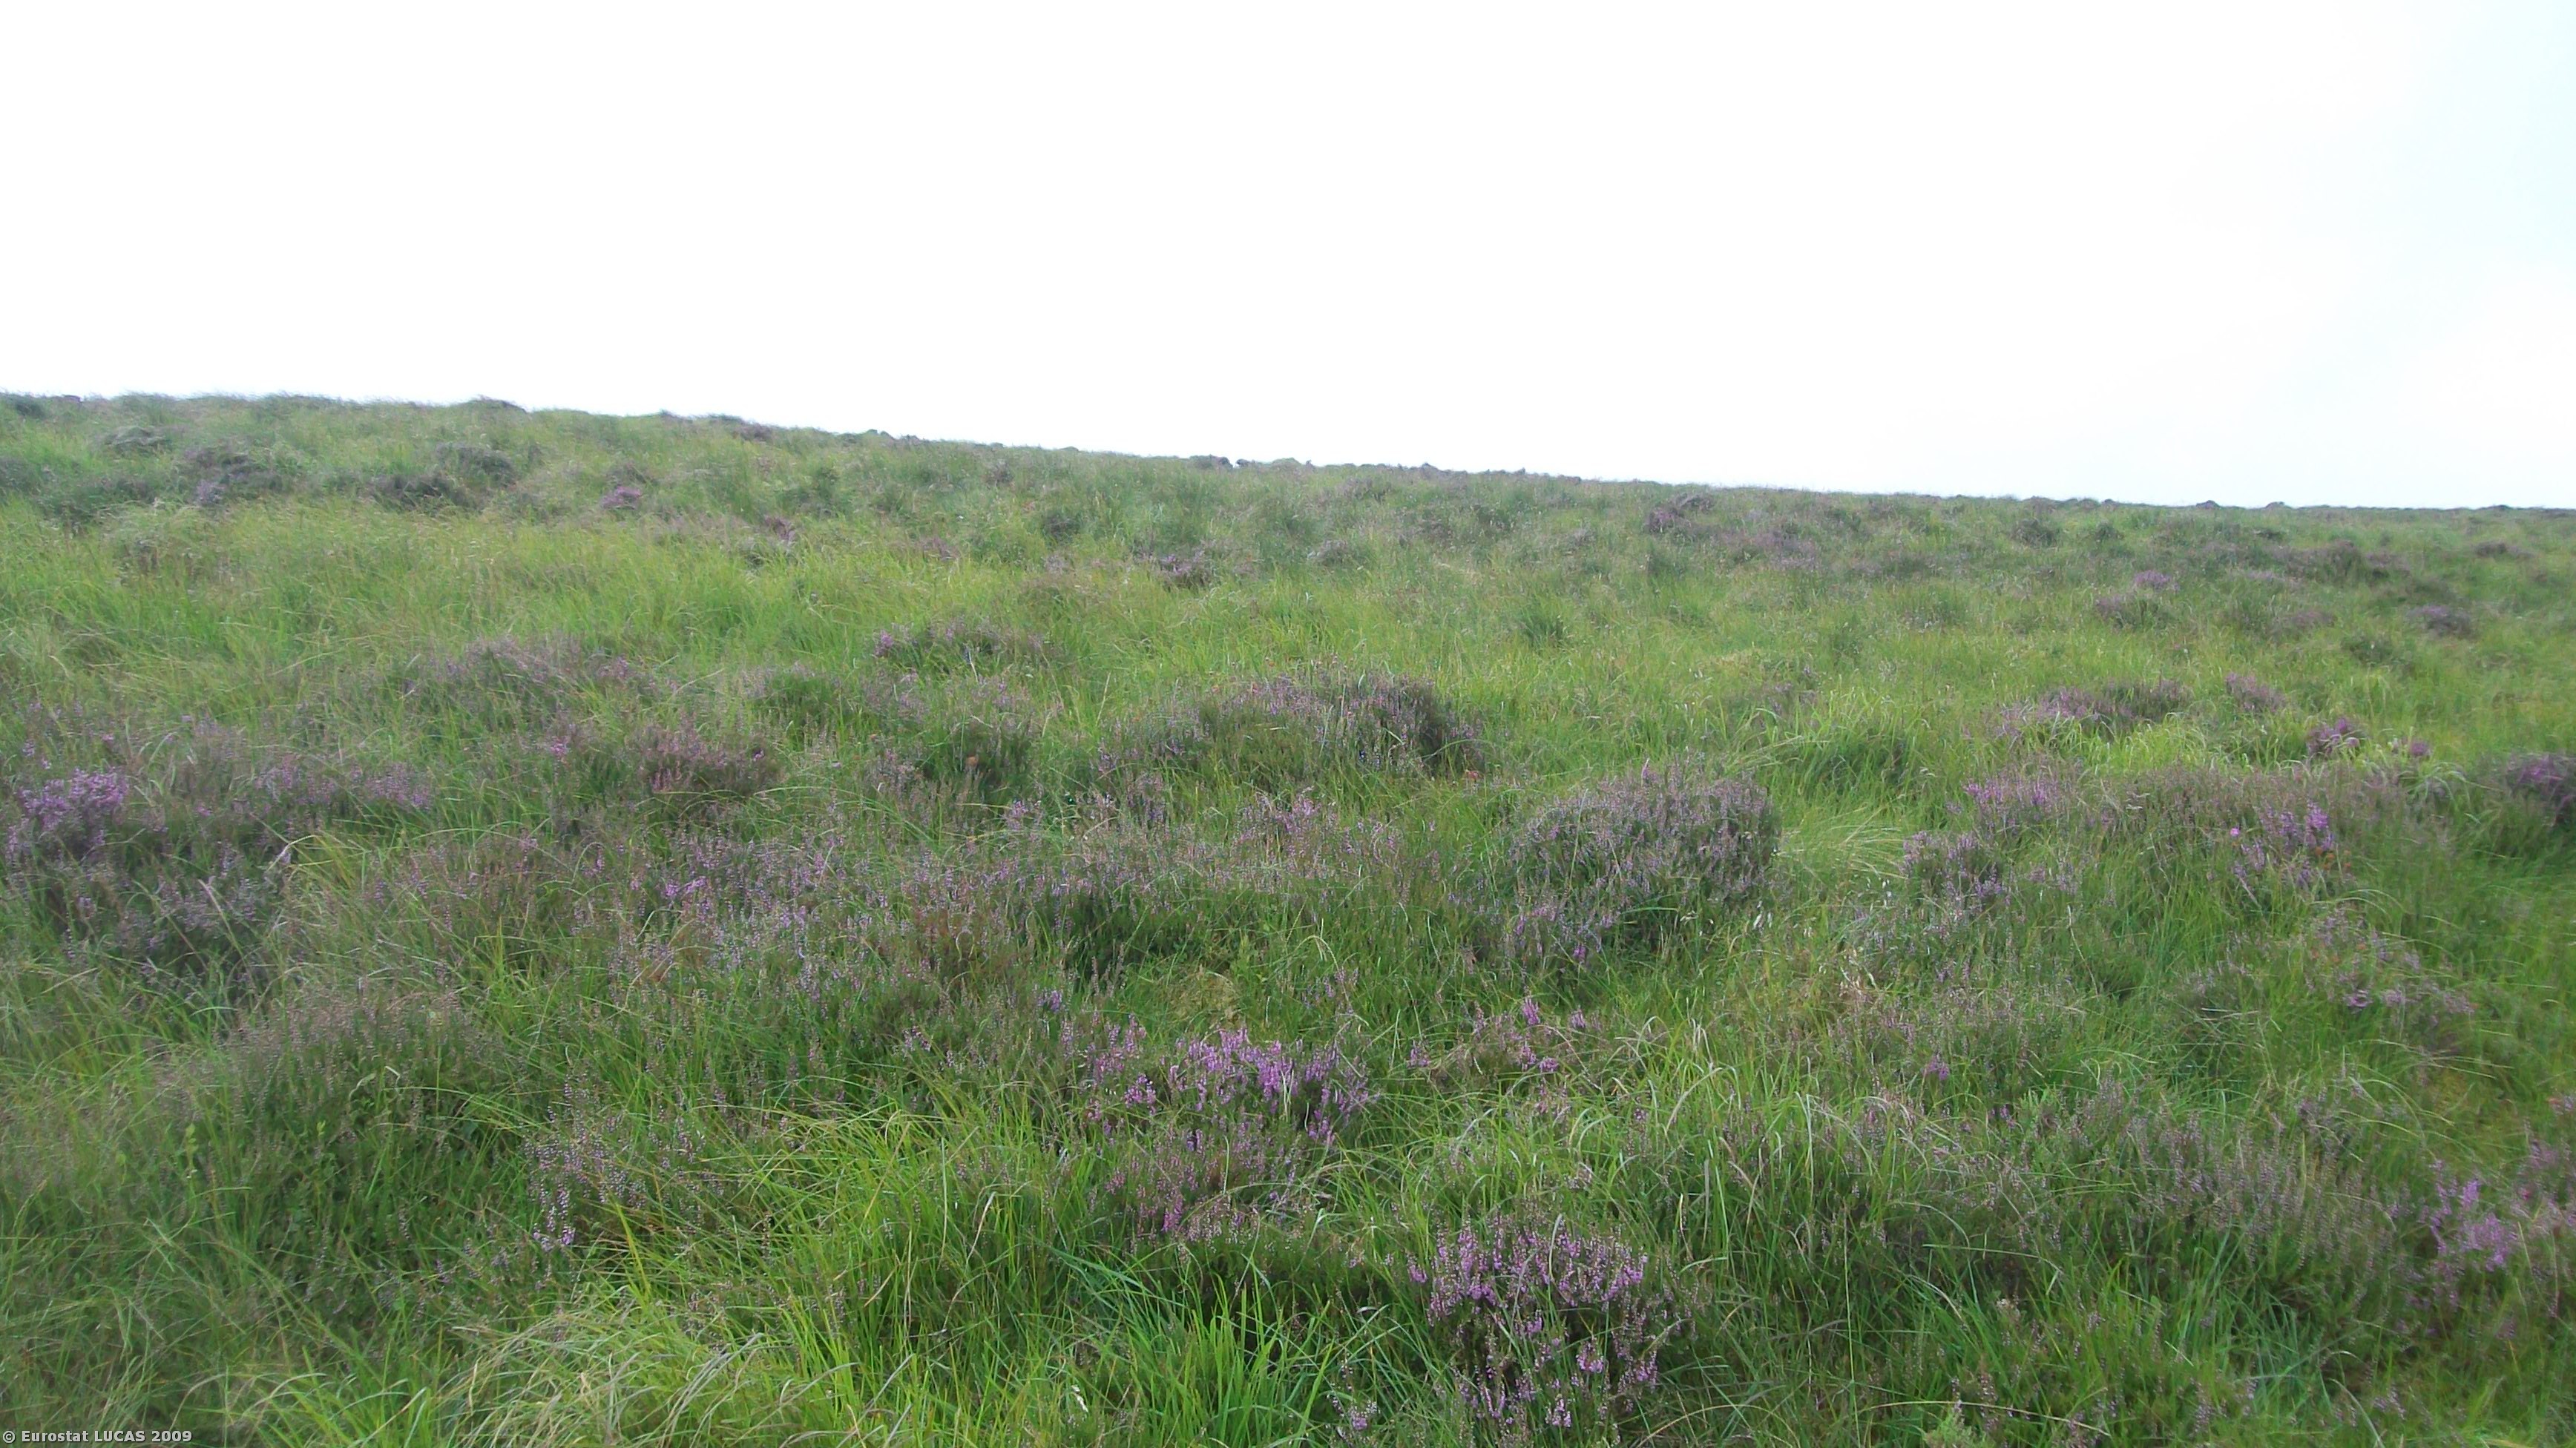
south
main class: Shrubland
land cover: Shrubland without tree cover
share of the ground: > 75 %
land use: Agriculture (excluding fallow land and kitchen gardens)
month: August
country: GB
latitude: 55.5109
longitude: -3.4588
